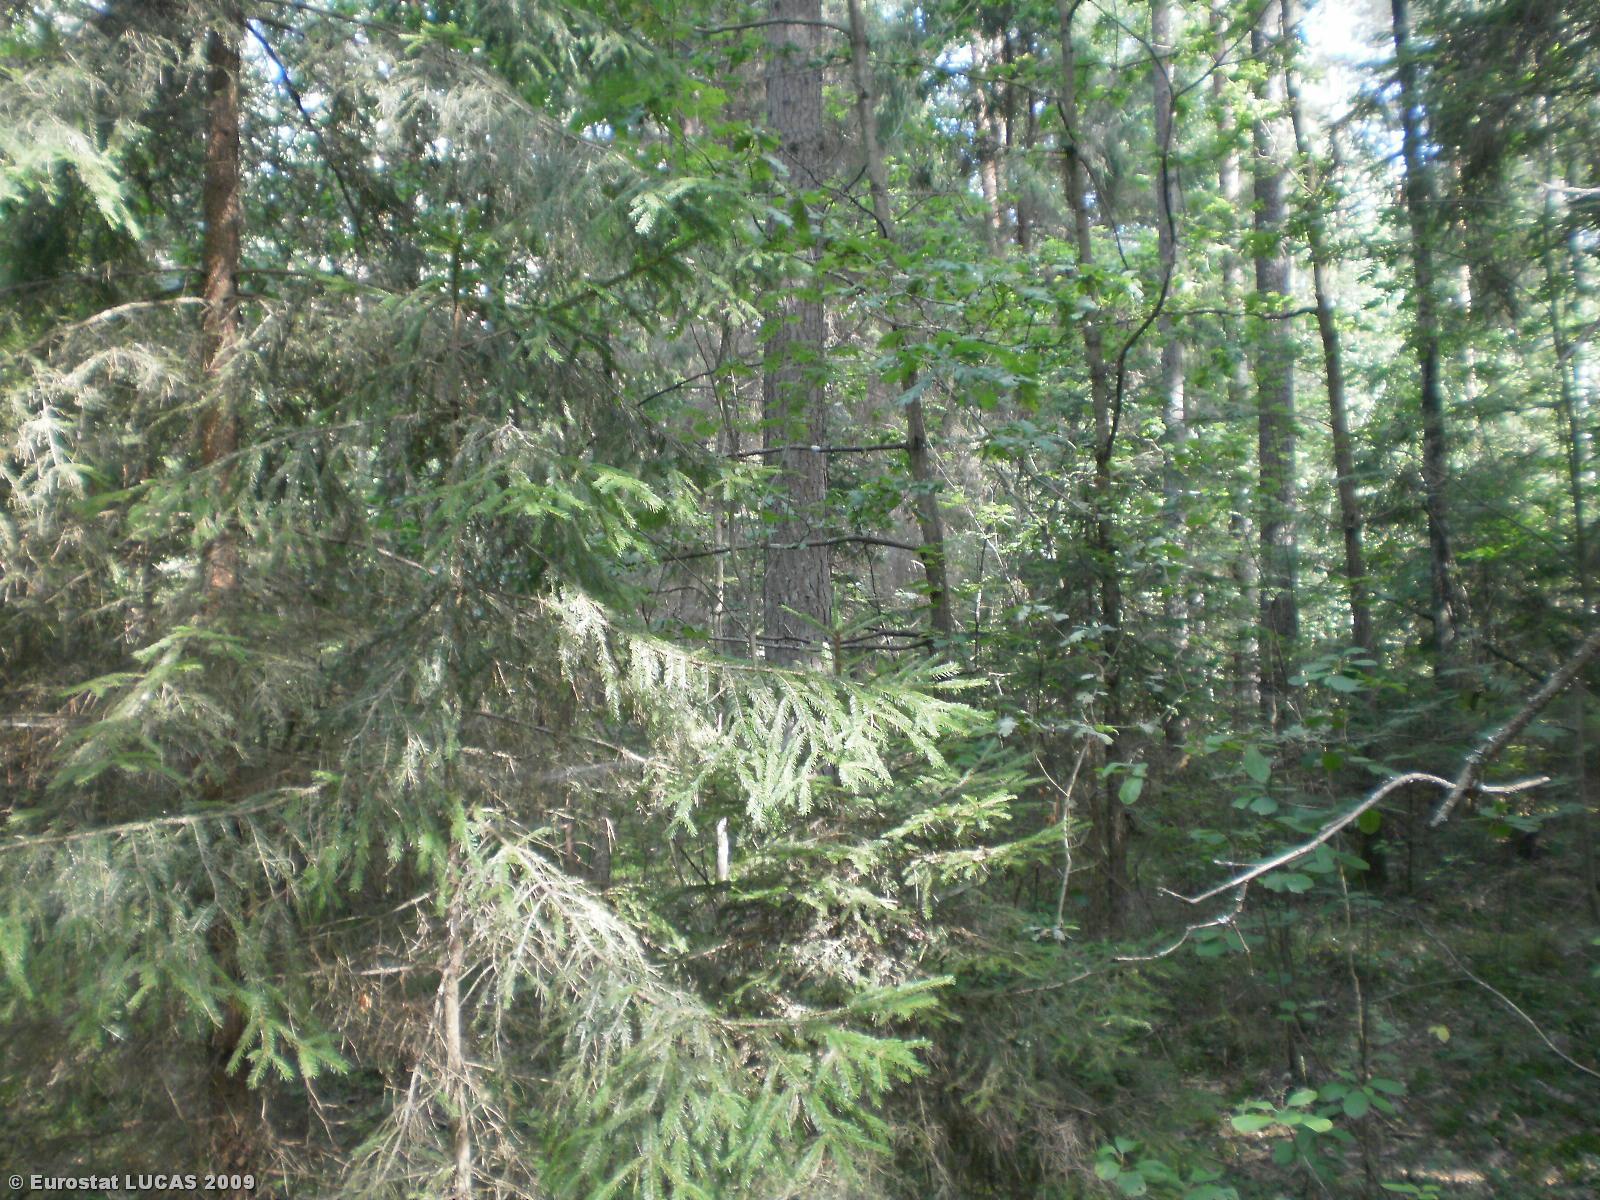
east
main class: Woodland
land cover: Mixed woodland
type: hemiboreal forest and nemoral coniferous forest and mixed broadleaved-coniferous forest
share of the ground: > 75 %
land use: Forestry
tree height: > 5 m
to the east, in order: Mixed woodland; Tracks; Mixed woodland
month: August
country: LT
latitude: 55.5581
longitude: 25.1286
